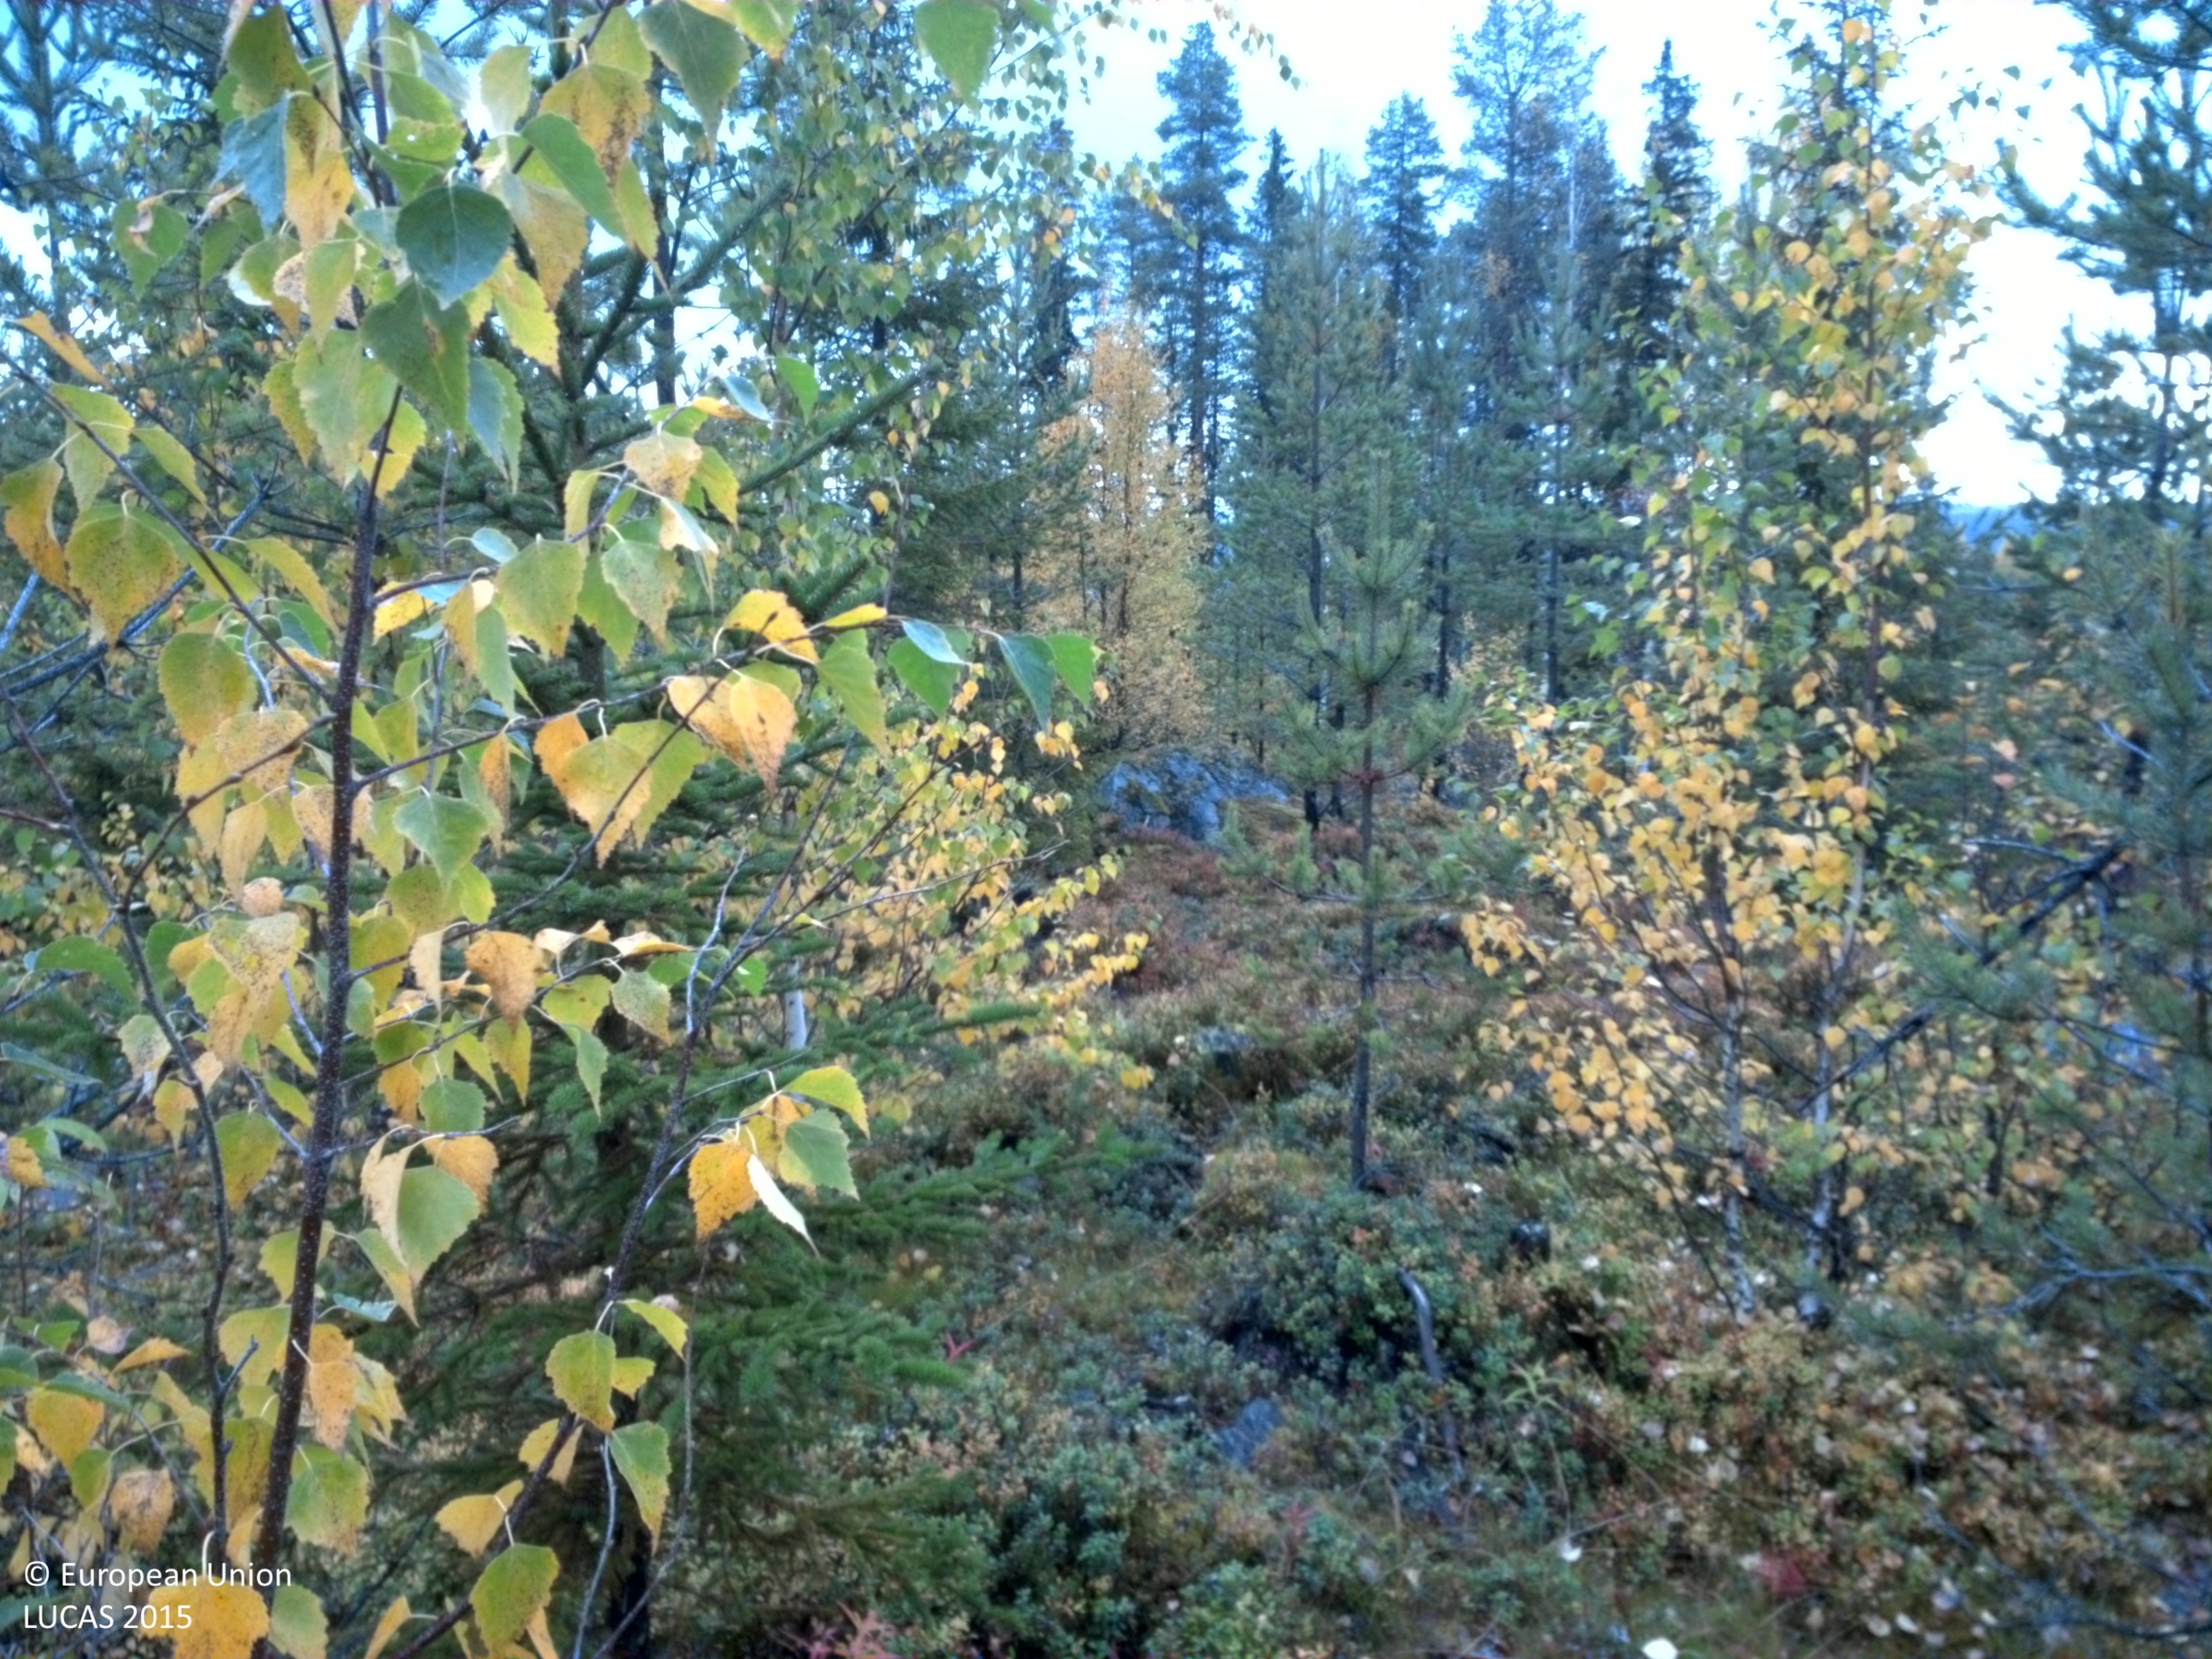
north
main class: Woodland
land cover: Pine dominated mixed woodland
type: boreal forest
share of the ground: 25 - 50 %
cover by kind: coniferous forest trees 30 %, shrubs 30 %, herbaceous plants 15 %, lichens and mosses 15 %, broadleaved forest trees 10 %
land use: Forestry
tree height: > 5 m
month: September
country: SE
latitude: 65.0735
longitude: 17.5121
